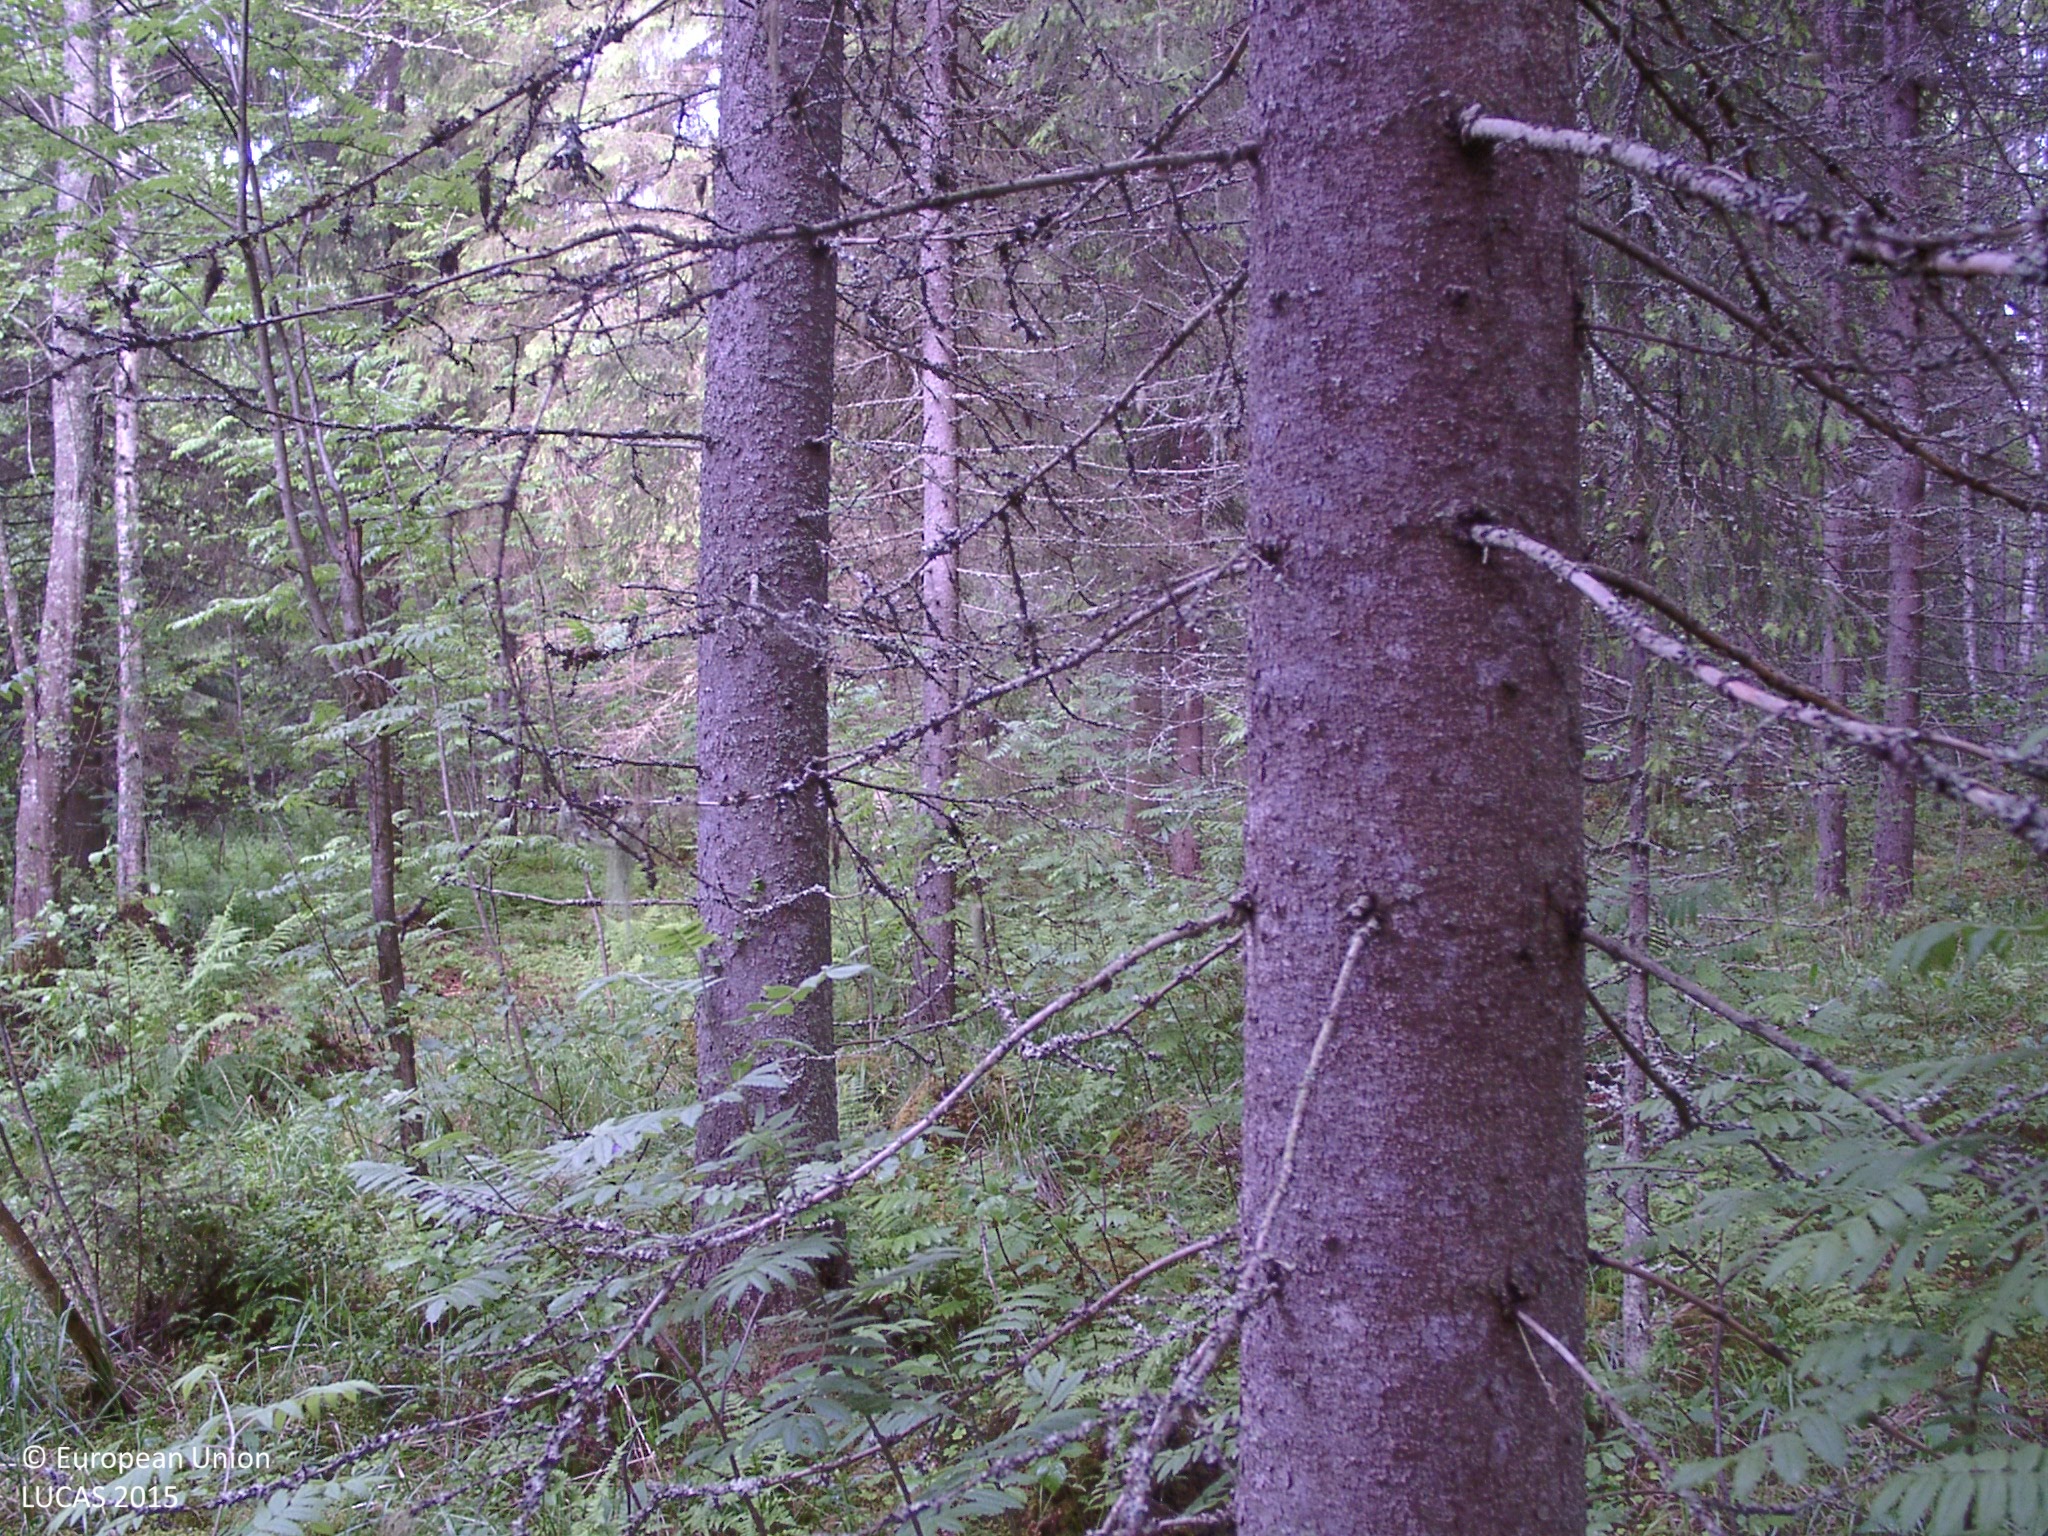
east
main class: Woodland
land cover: Spruce dominated coniferous woodland
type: boreal forest
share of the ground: 50 - 75 %
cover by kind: coniferous forest trees 60 %, herbaceous plants 15 %, lichens and mosses 15 %, broadleaved forest trees 10 %
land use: Forestry
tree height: > 5 m
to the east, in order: Spruce dominated coniferous woodland; Grassland with sparse tree/shrub cover; Spruce dominated coniferous woodland; Spruce dominated mixed woodland; Electric lines; Grassland with sparse tree/shrub cover; Tracks; Other mixed woodland; Artificial constructions in urban areas
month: June
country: FI
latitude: 61.5930
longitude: 24.8595
